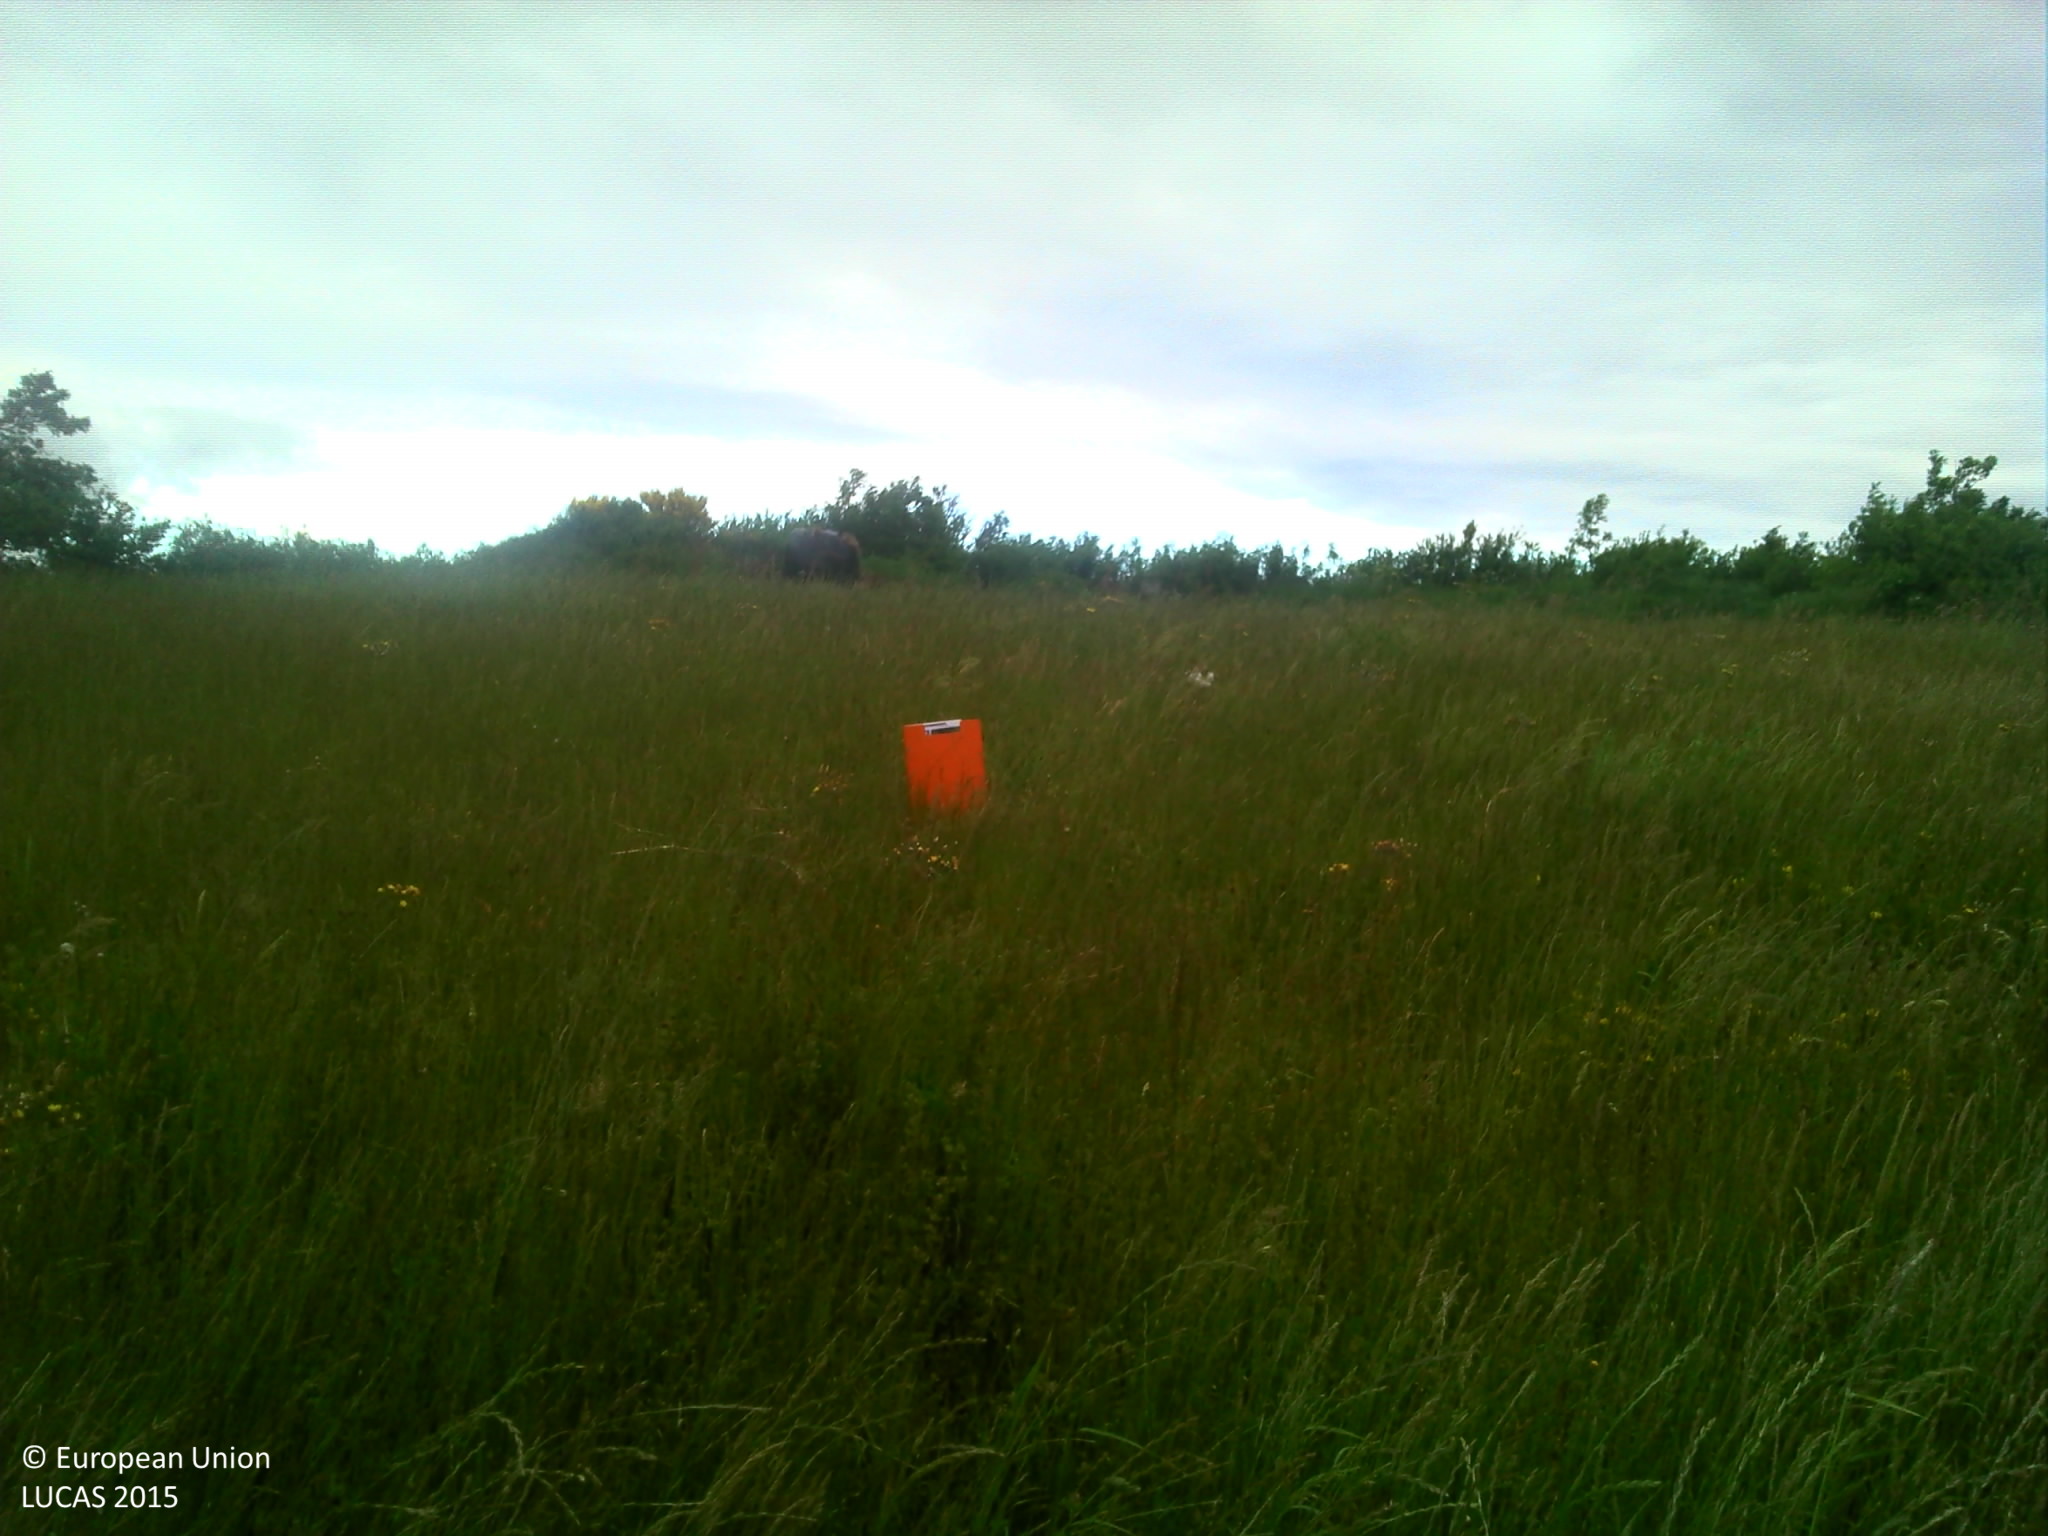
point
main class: Grassland
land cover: Grassland without tree/shrub cover
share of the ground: > 75 %
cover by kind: herbaceous plants 100 %
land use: Agriculture (excluding fallow land and kitchen gardens)
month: June
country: FR
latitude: 45.1778
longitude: 3.2196
